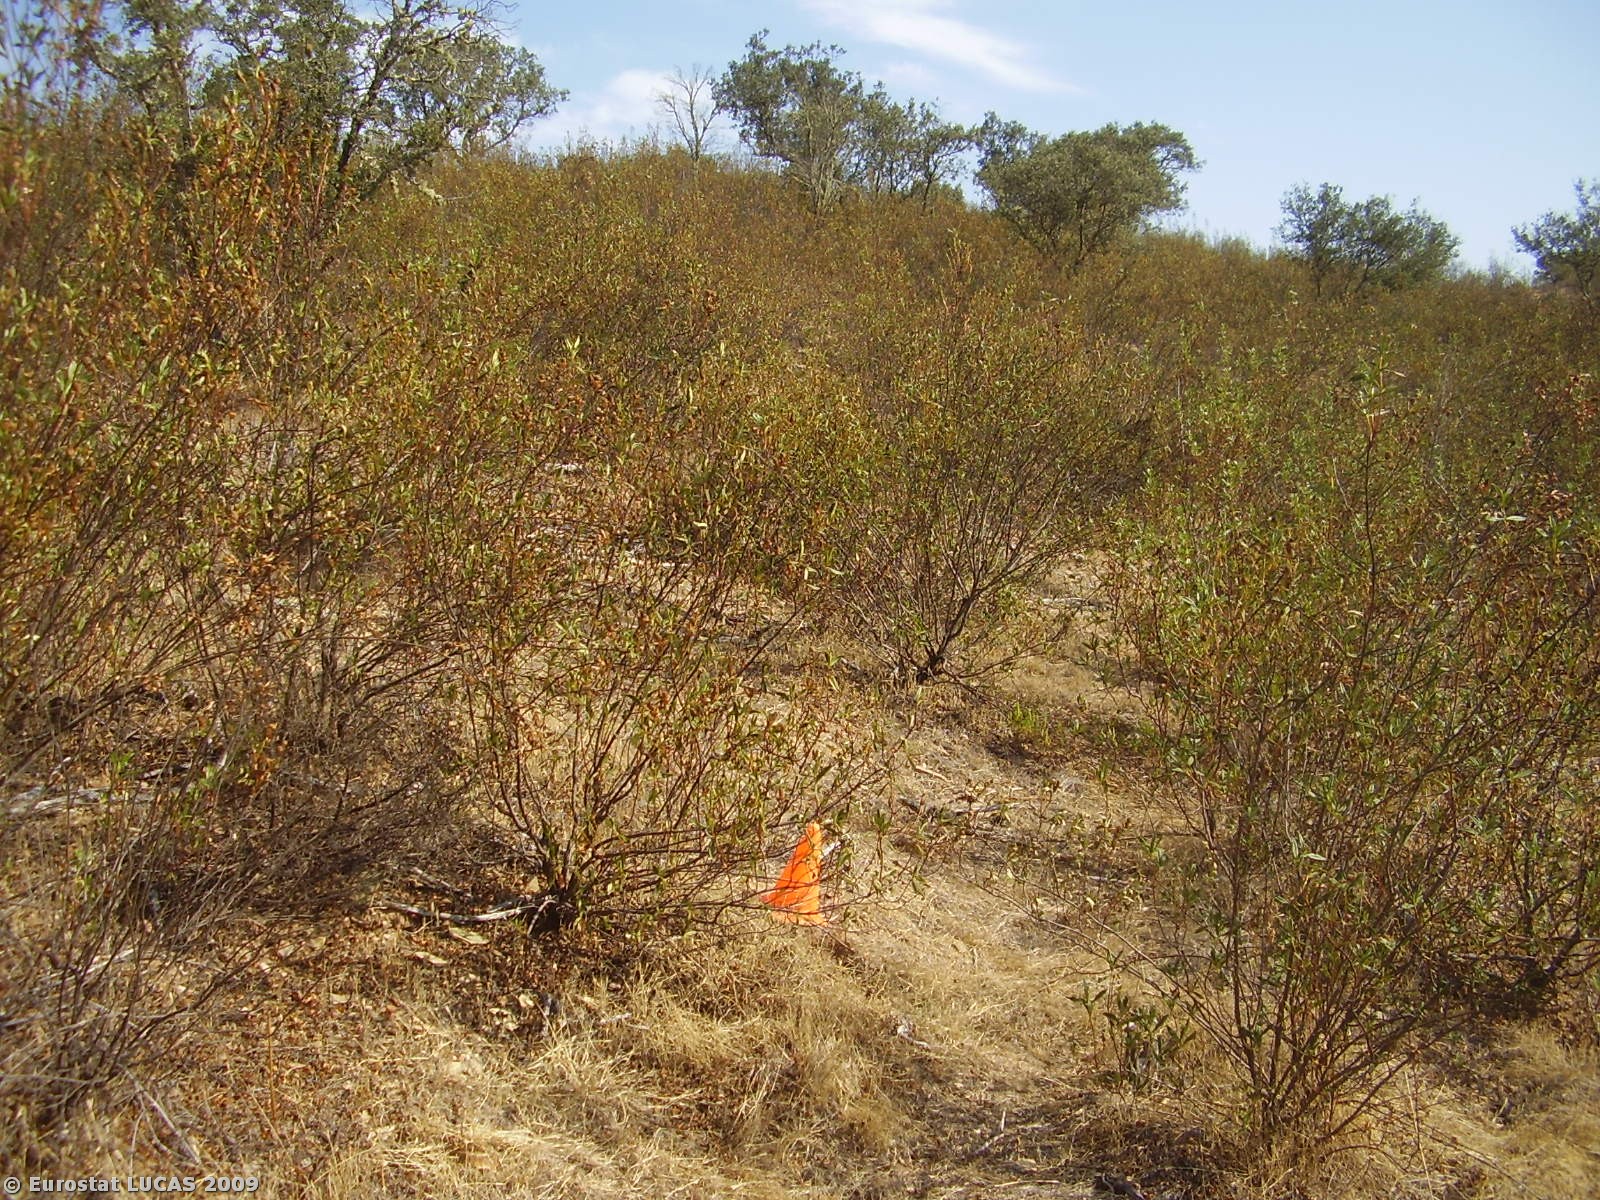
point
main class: Woodland
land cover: Broadleaved woodland
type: broadleaved evergreen forest
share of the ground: 10 - 25 %
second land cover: Grassland with sparse tree/shrub cover
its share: > 75 %
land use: Forestry
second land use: Fallow land
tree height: > 5 m
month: August
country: PT
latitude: 38.3337
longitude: -7.7754
